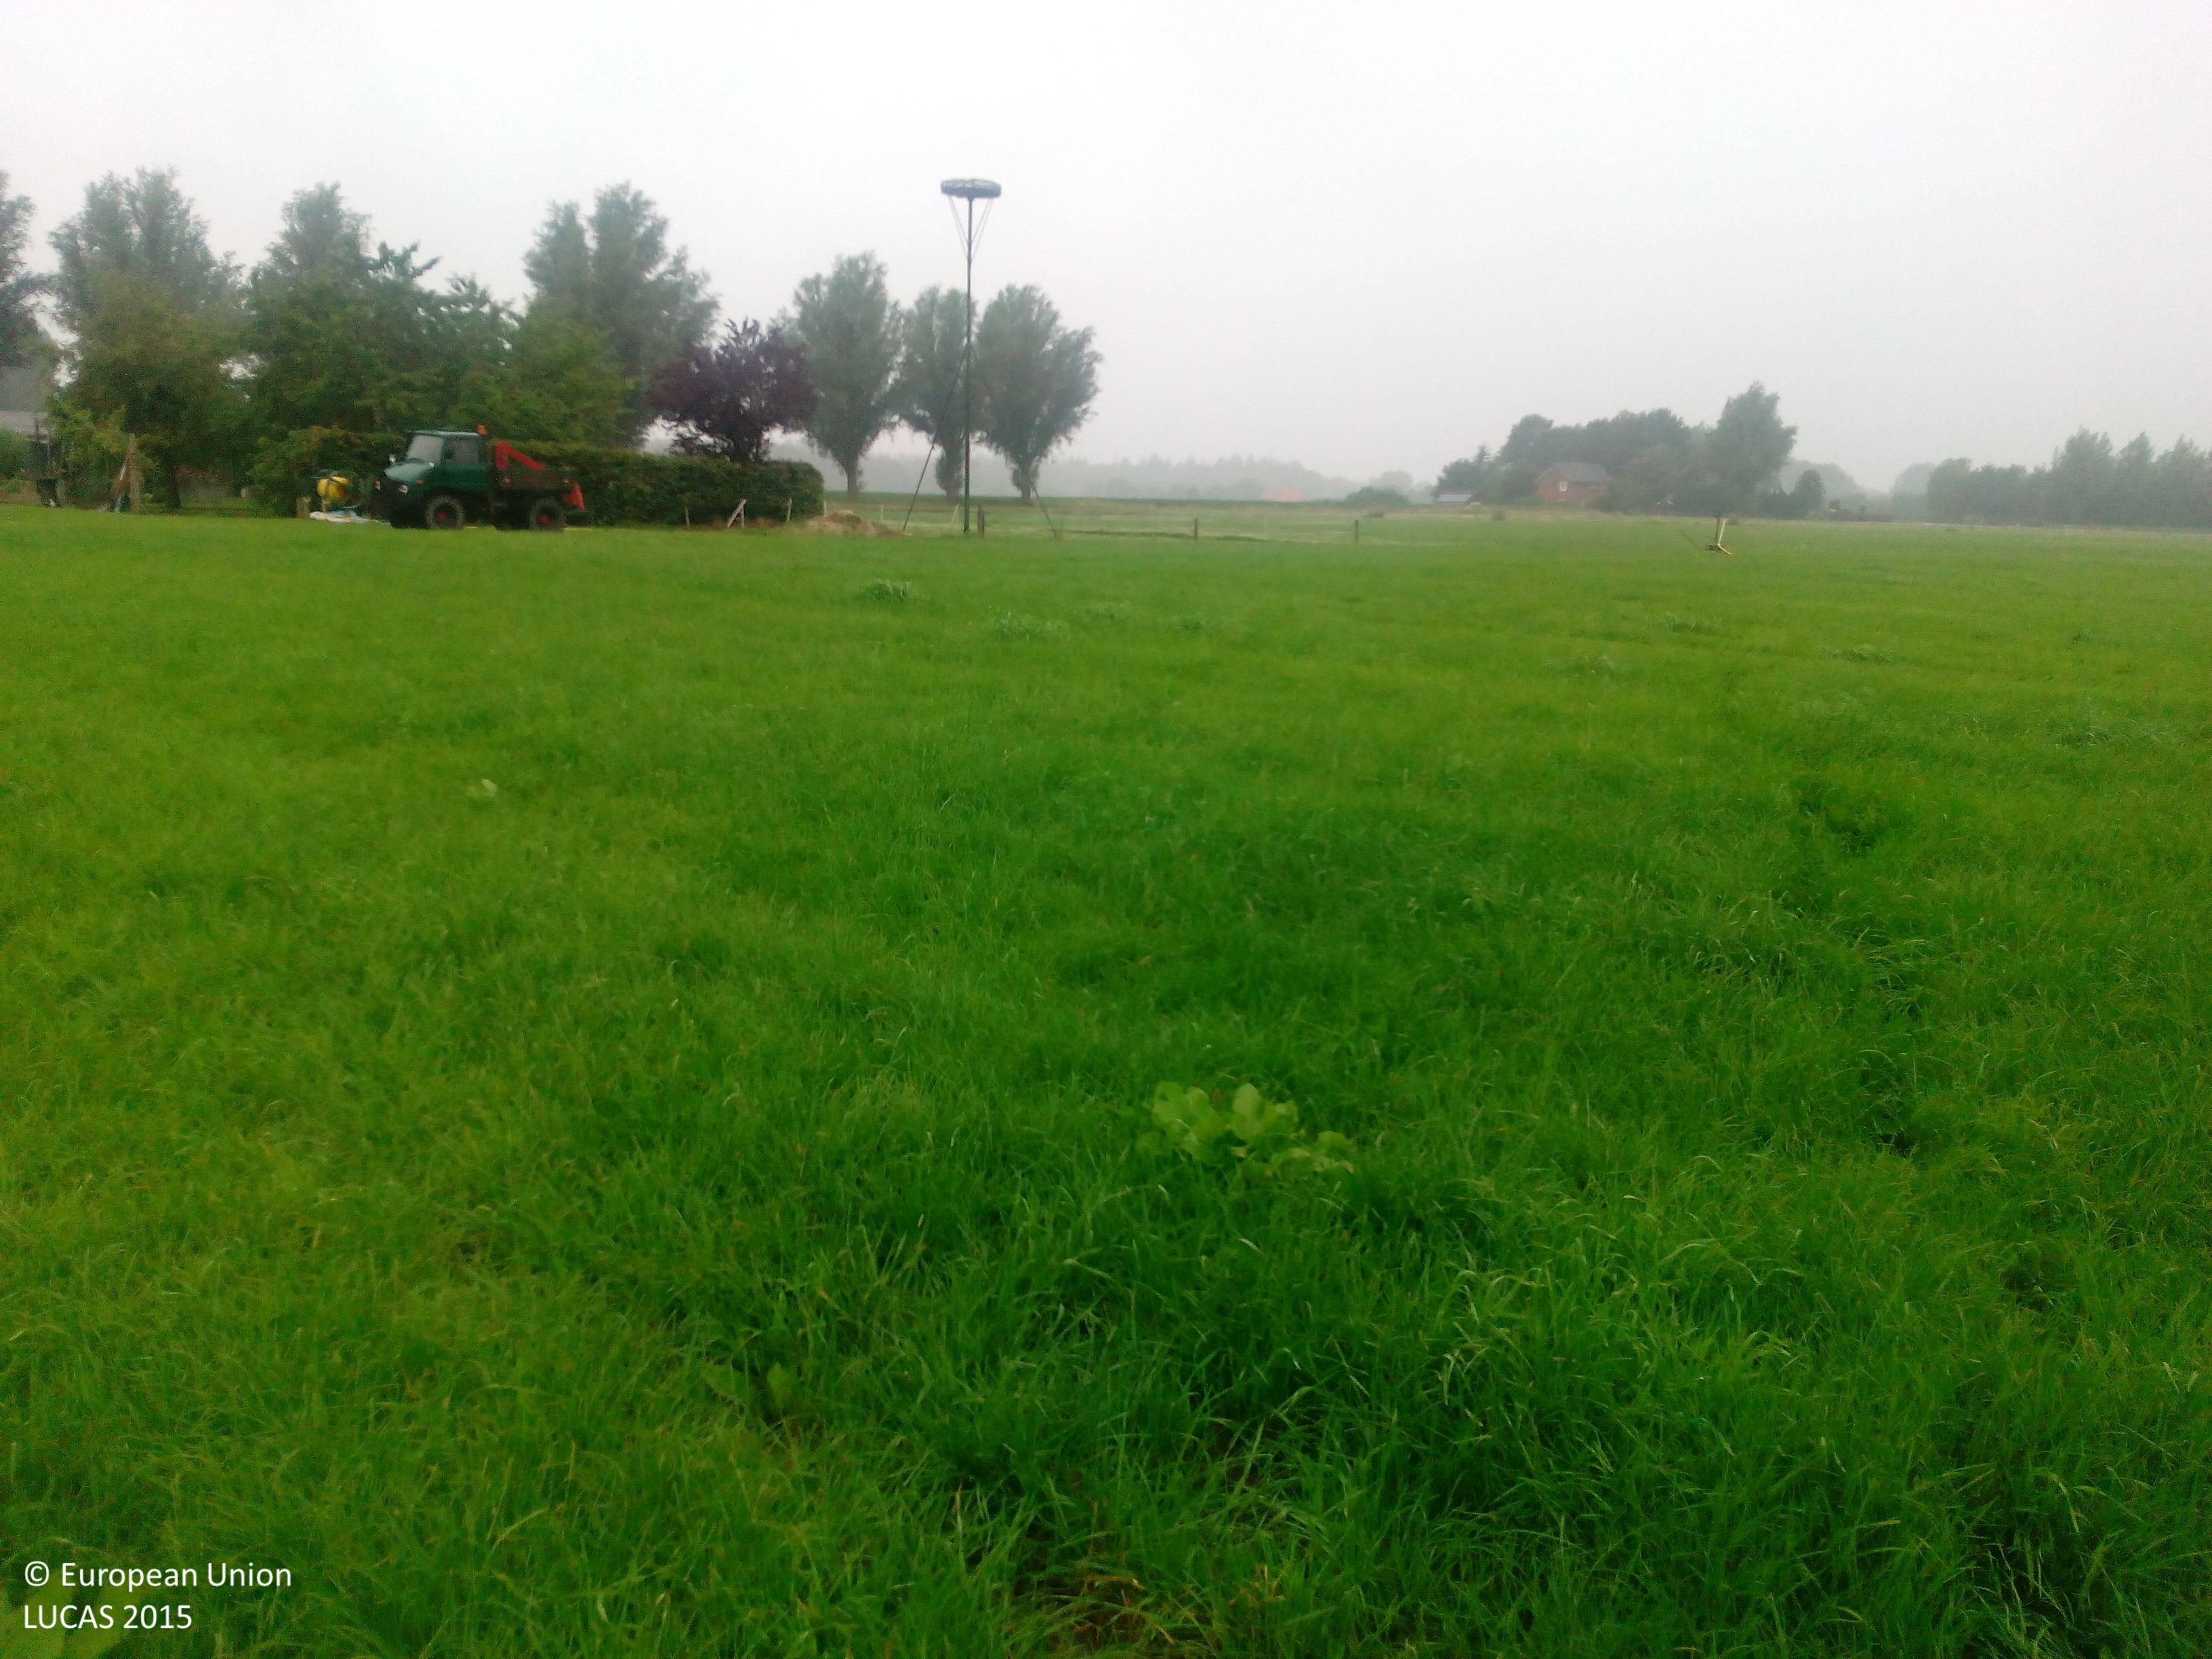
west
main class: Cropland
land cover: Maize
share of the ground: > 75 %
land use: Agriculture (excluding fallow land and kitchen gardens)
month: July
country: NL
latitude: 51.9955
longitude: 6.2855
